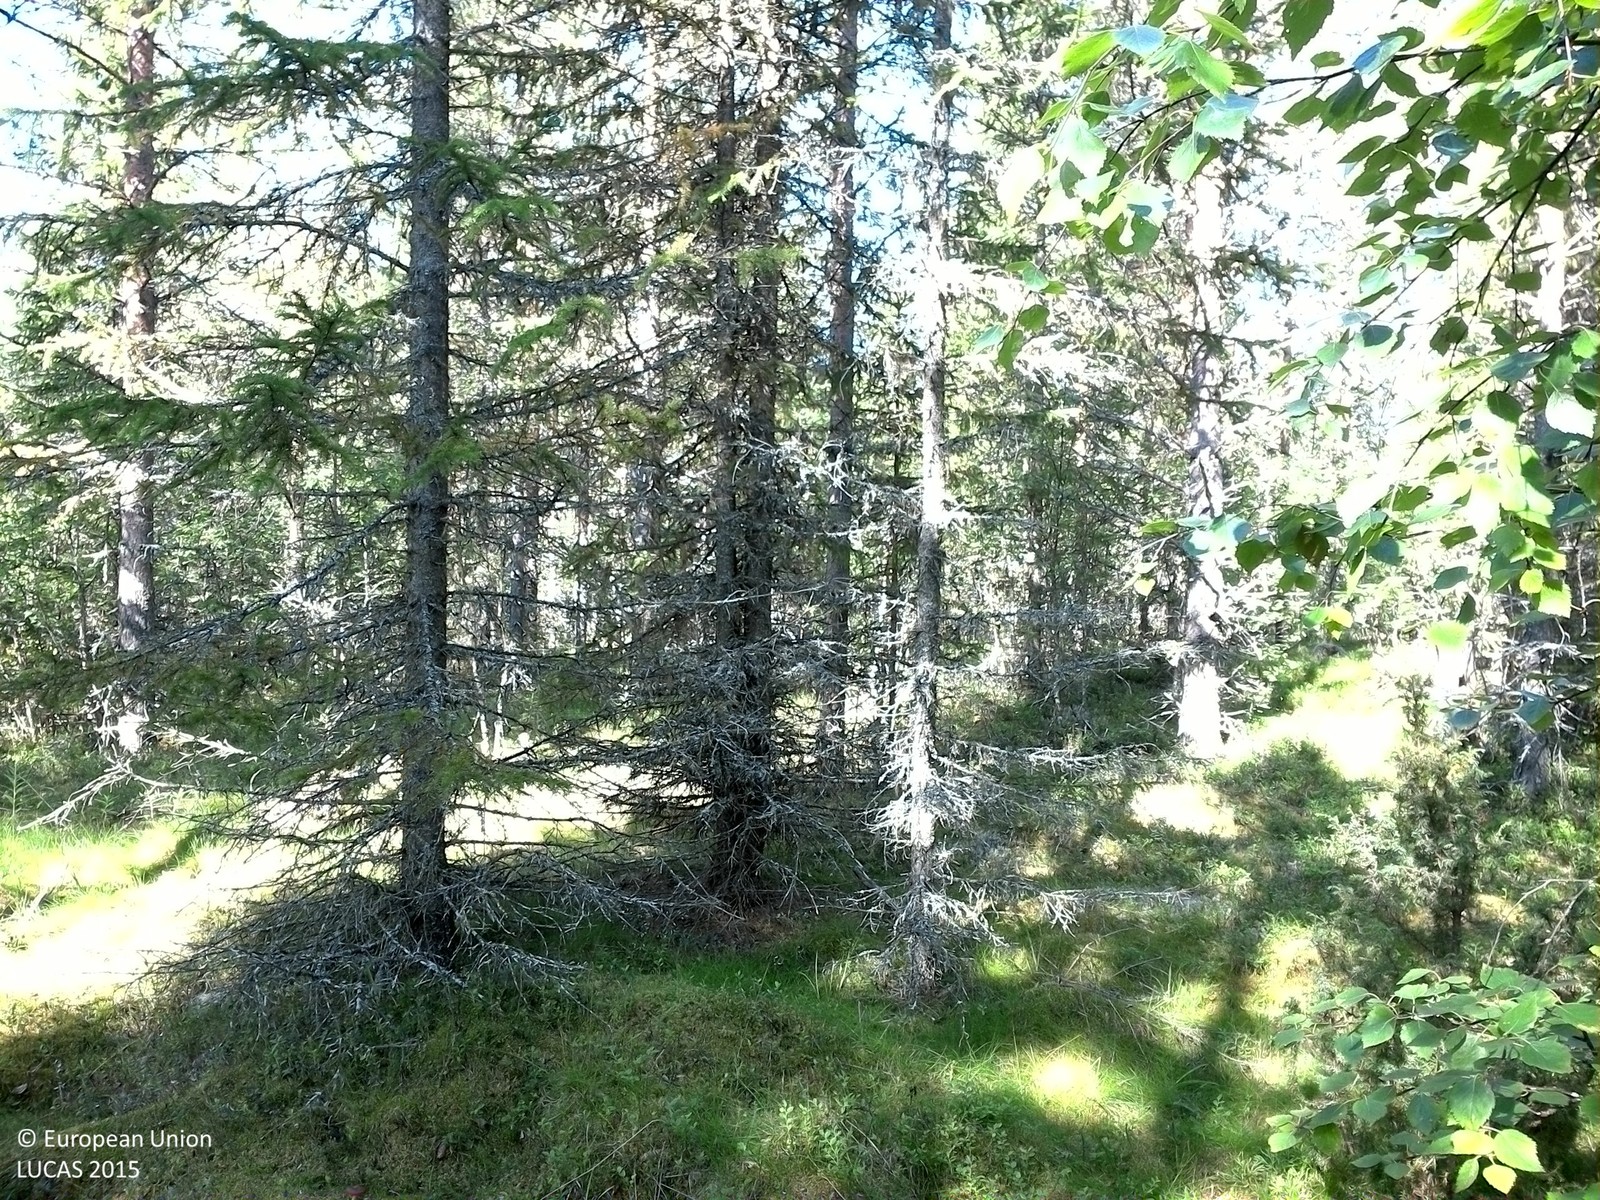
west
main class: Woodland
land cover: Pine dominated coniferous woodland
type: boreal forest
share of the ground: 50 - 75 %
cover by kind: coniferous forest trees 65 %, broadleaved forest trees 10 %, shrubs 10 %, lichens and mosses 10 %, herbaceous plants 5 %
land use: Forestry
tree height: > 5 m
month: August
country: SE
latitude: 63.7235
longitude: 18.0109
